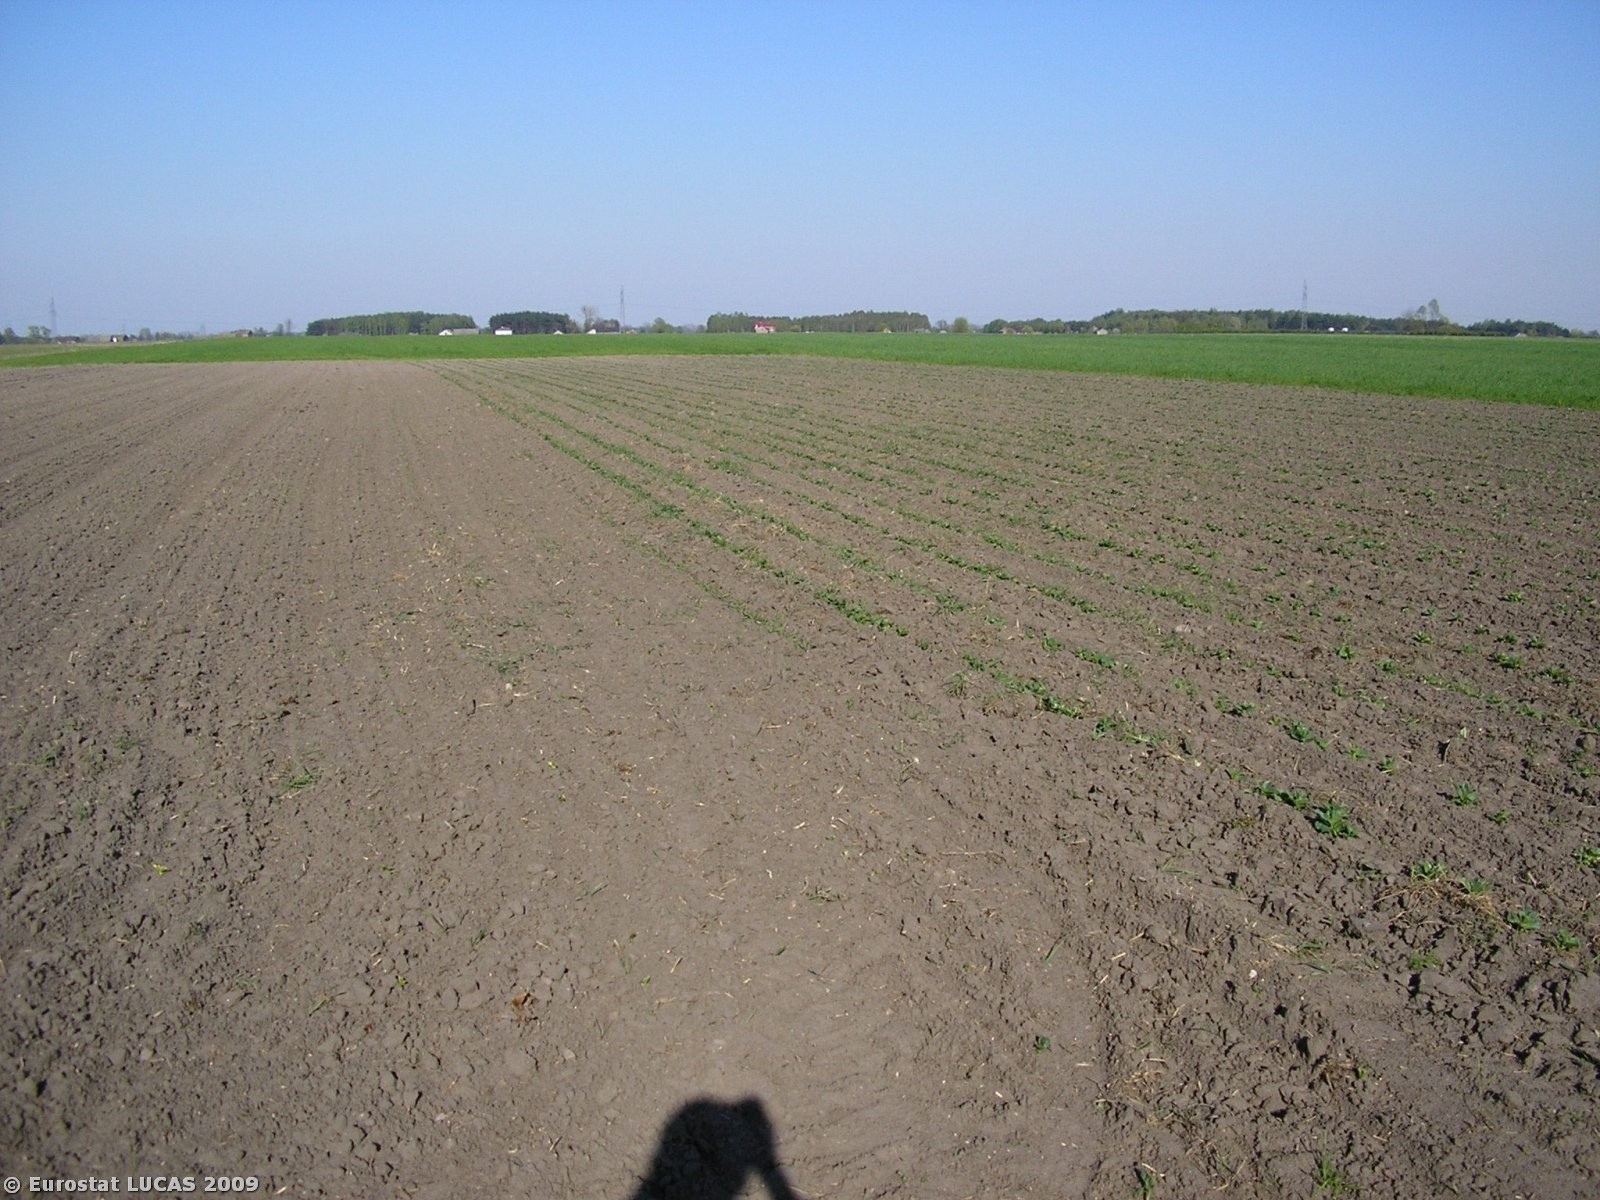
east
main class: Grassland
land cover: Spontaneously vegetated surfaces
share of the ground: > 75 %
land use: Unused
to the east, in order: Spontaneously vegetated surfaces; Other fresh vegetables; Triticale; Common wheat
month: April
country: PL
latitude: 52.1092
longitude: 20.0941
